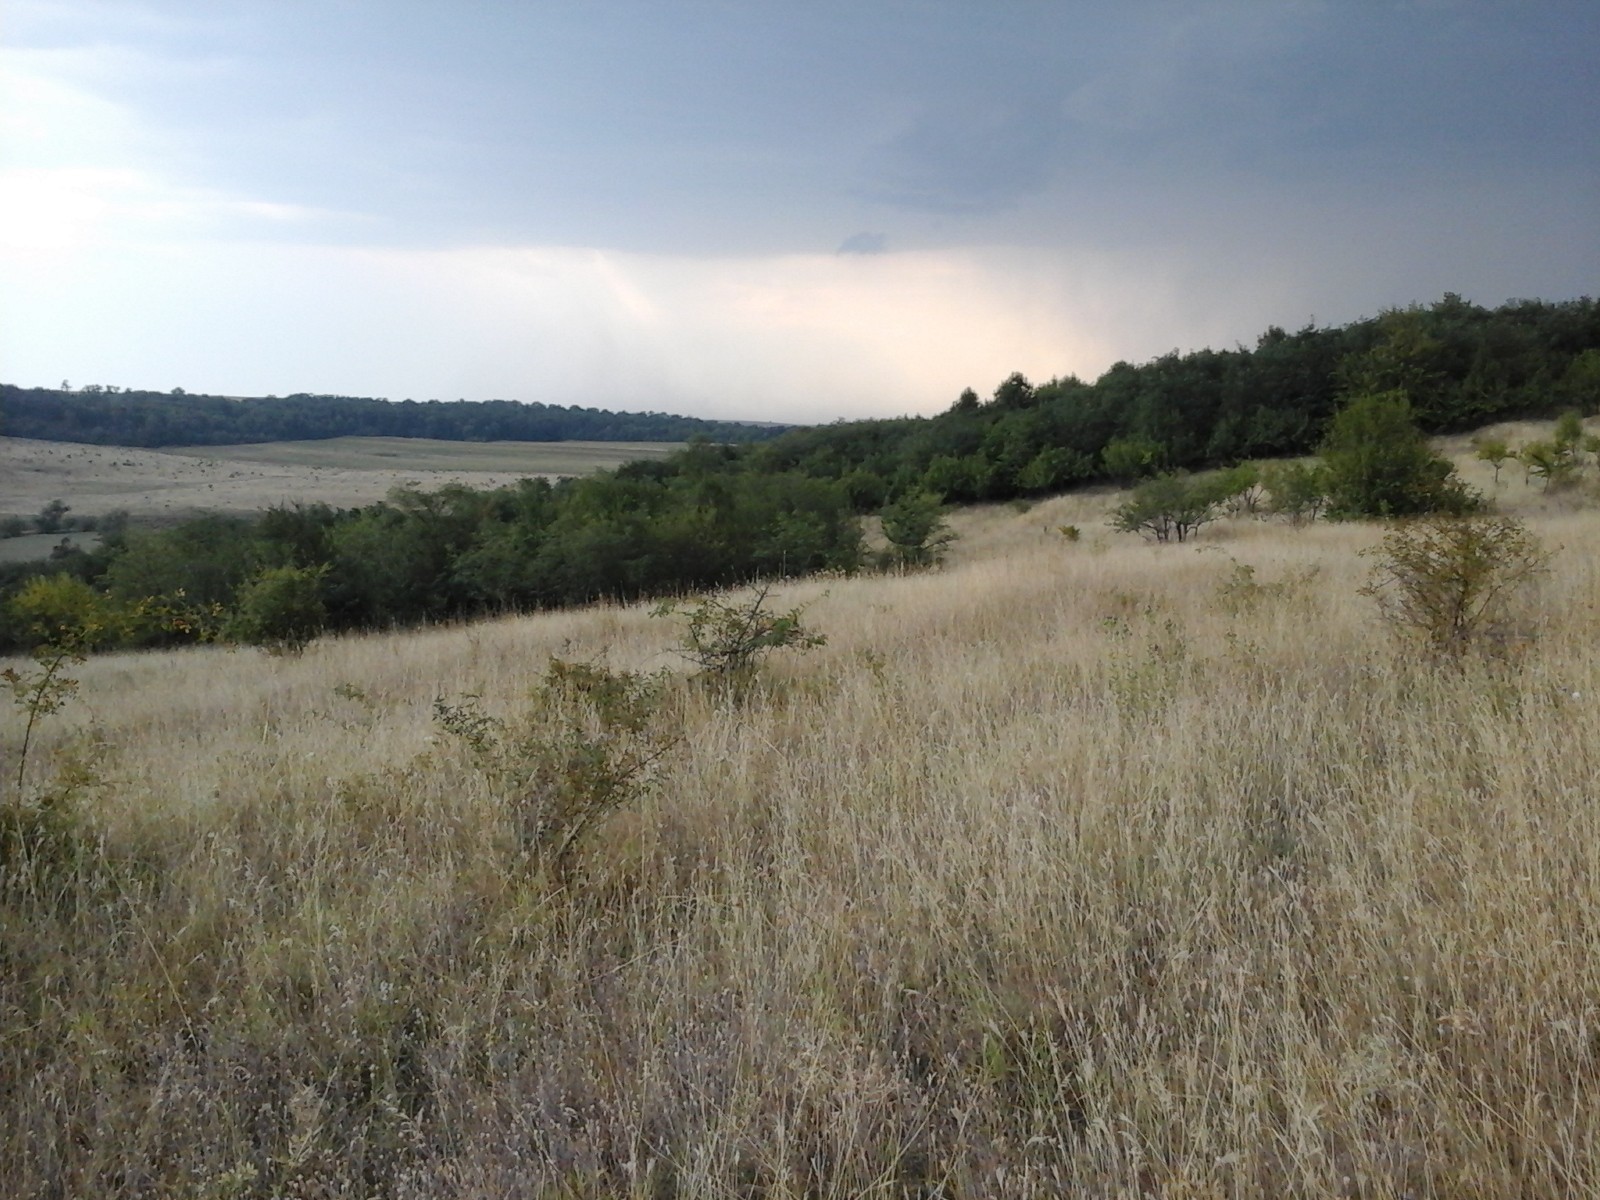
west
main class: Grassland
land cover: Grassland with sparse tree/shrub cover
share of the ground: > 75 %
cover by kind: herbaceous plants 90 %, broadleaved forest trees 5 %, shrubs 5 %
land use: Agriculture (excluding fallow land and kitchen gardens)
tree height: < 5 m
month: August
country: RO
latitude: 44.3181
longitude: 23.2504
